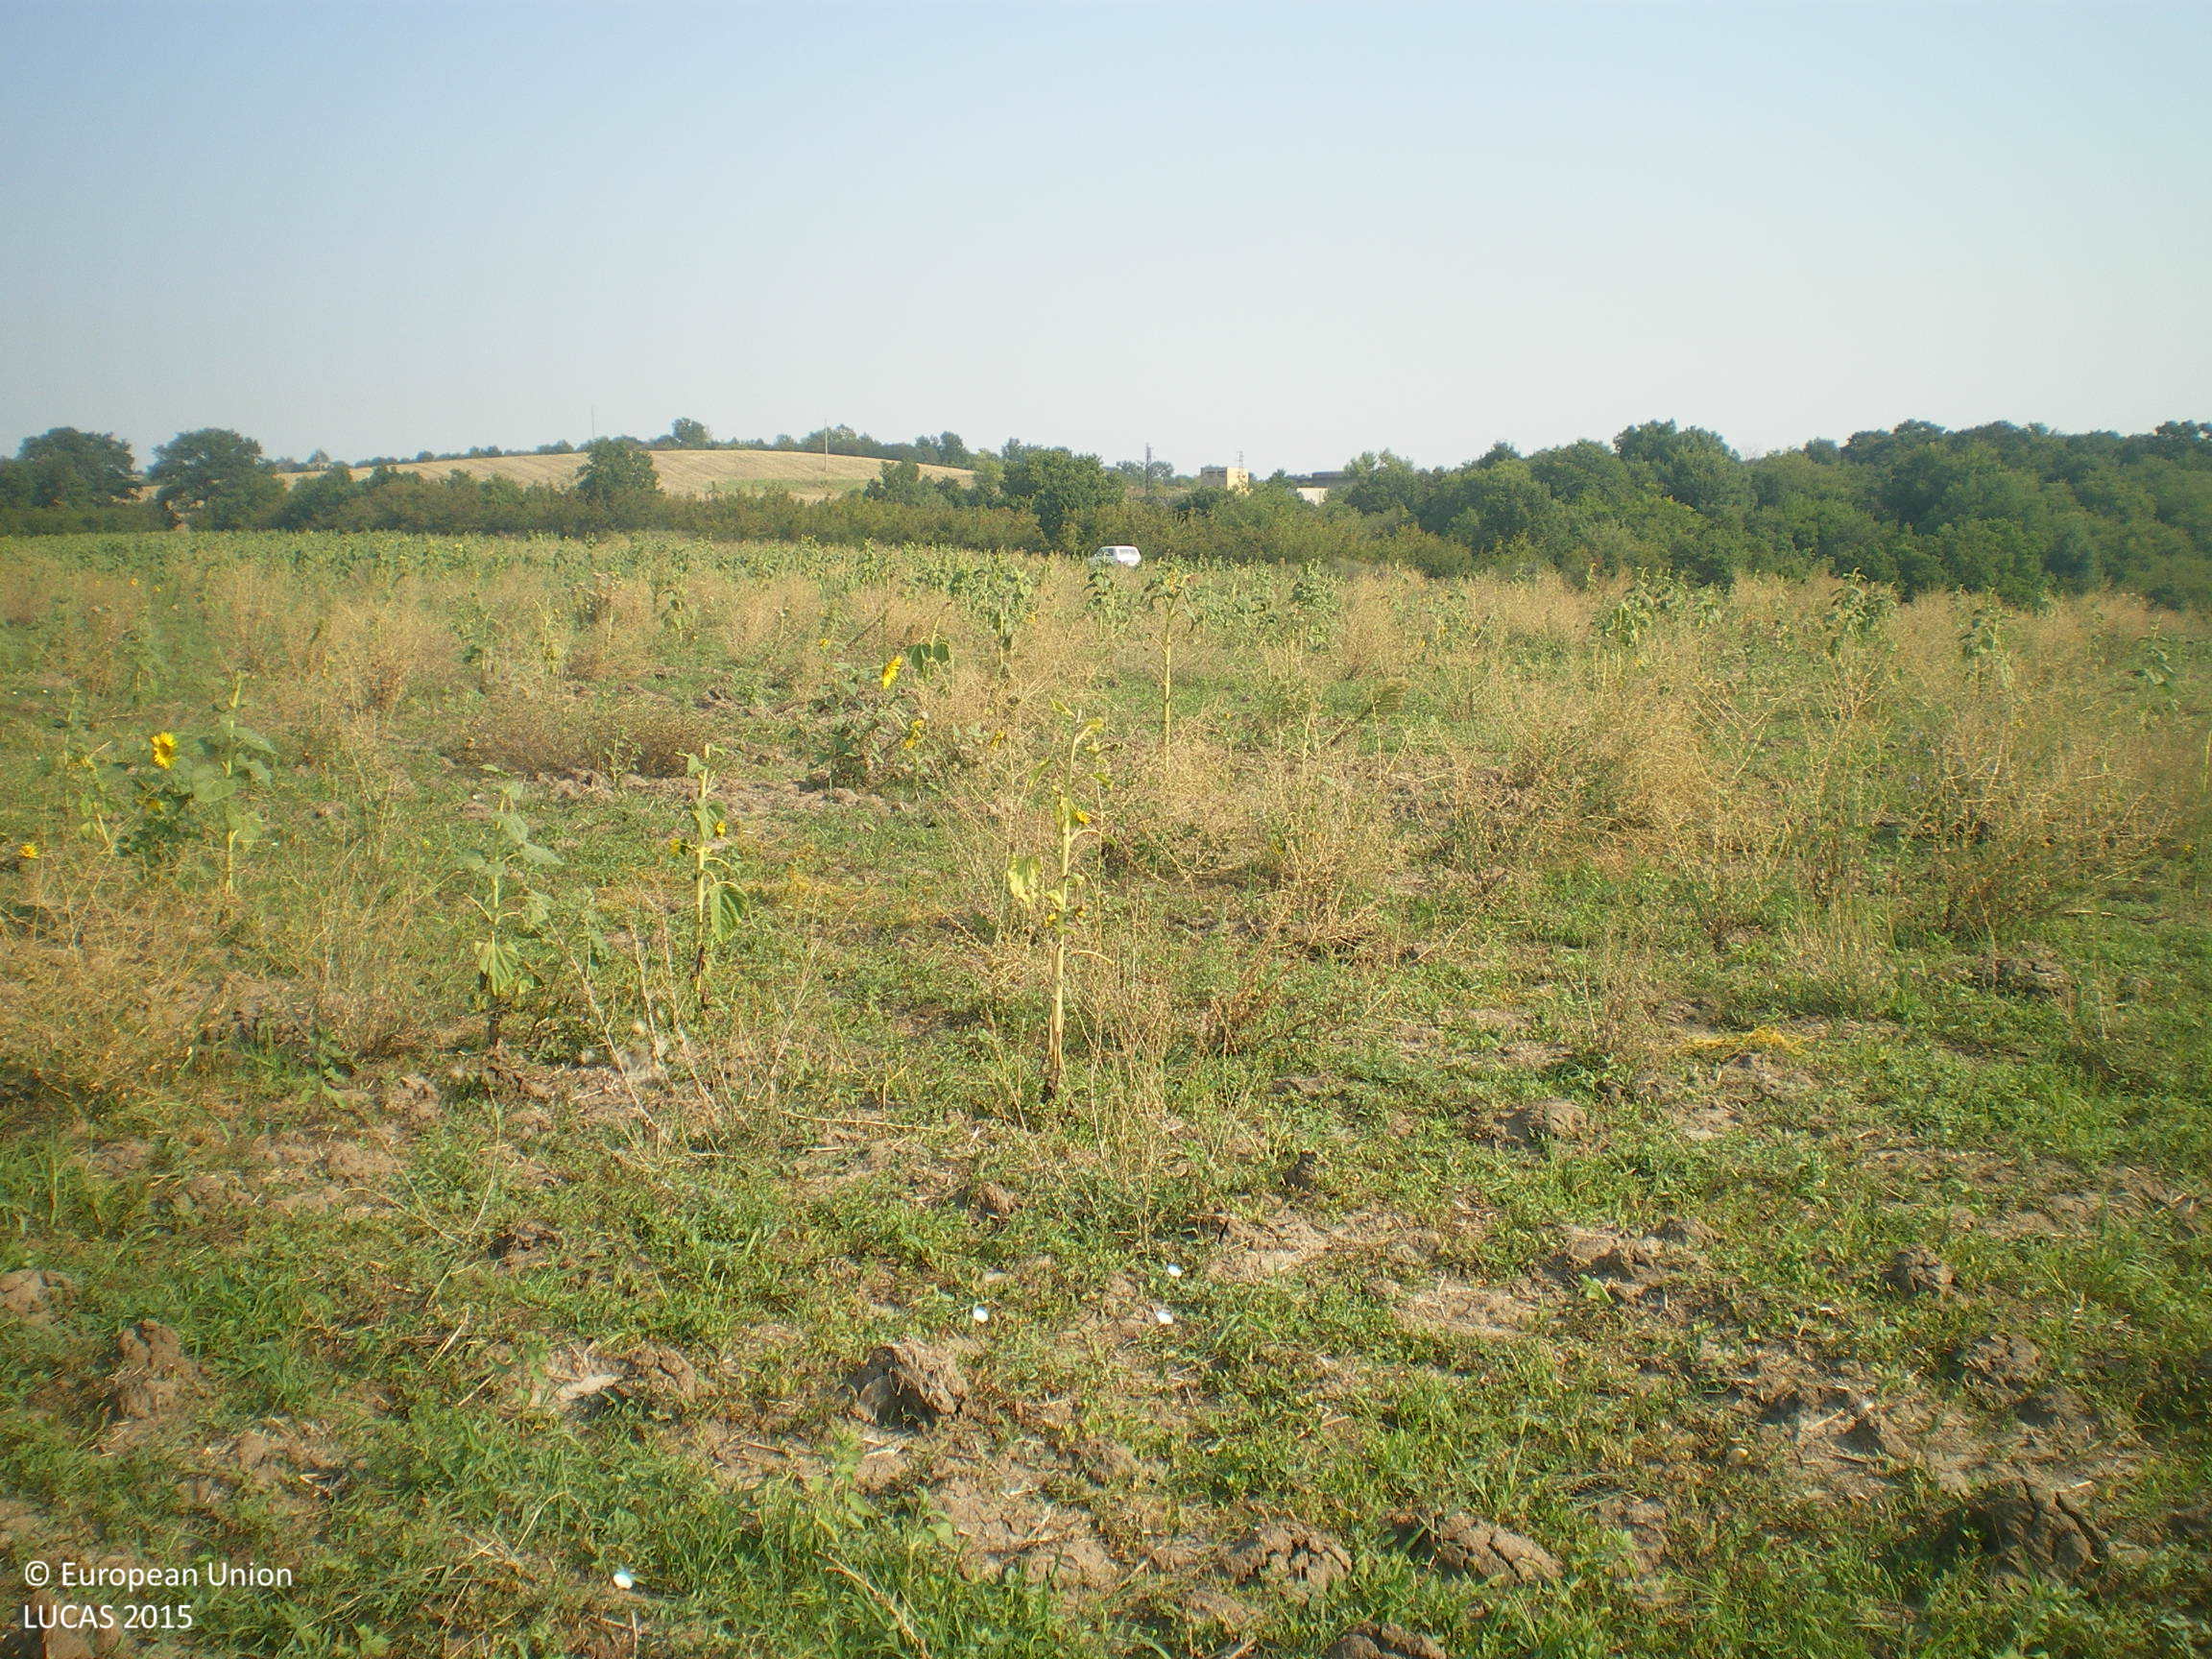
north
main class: Cropland
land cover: Sunflower
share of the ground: < 10 %
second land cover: Spontaneously vegetated surfaces
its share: > 75 %
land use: Agriculture (excluding fallow land and kitchen gardens)
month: August
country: BG
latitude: 41.9637
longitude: 25.8654
